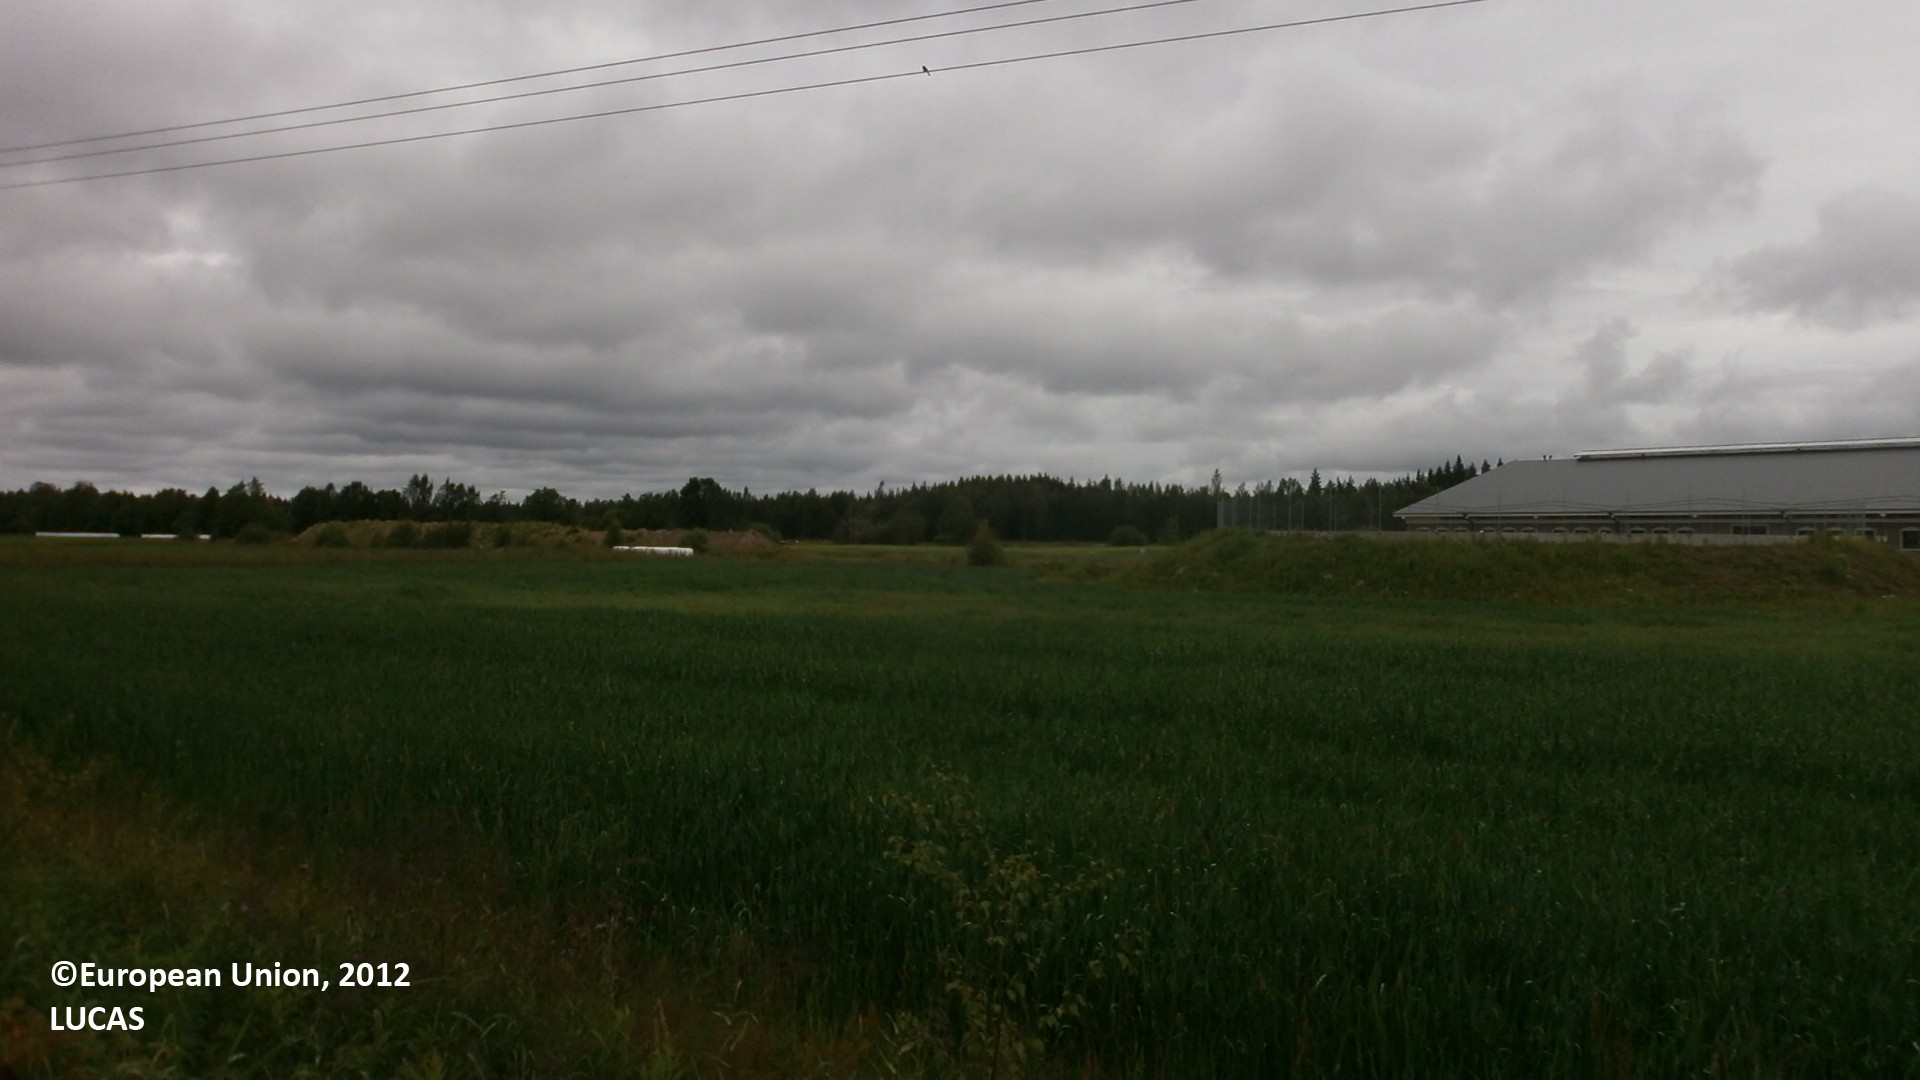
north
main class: Grassland
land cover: Grassland without tree/shrub cover
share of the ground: > 75 %
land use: Road transport
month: July
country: FI
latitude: 63.9781
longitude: 23.7701
